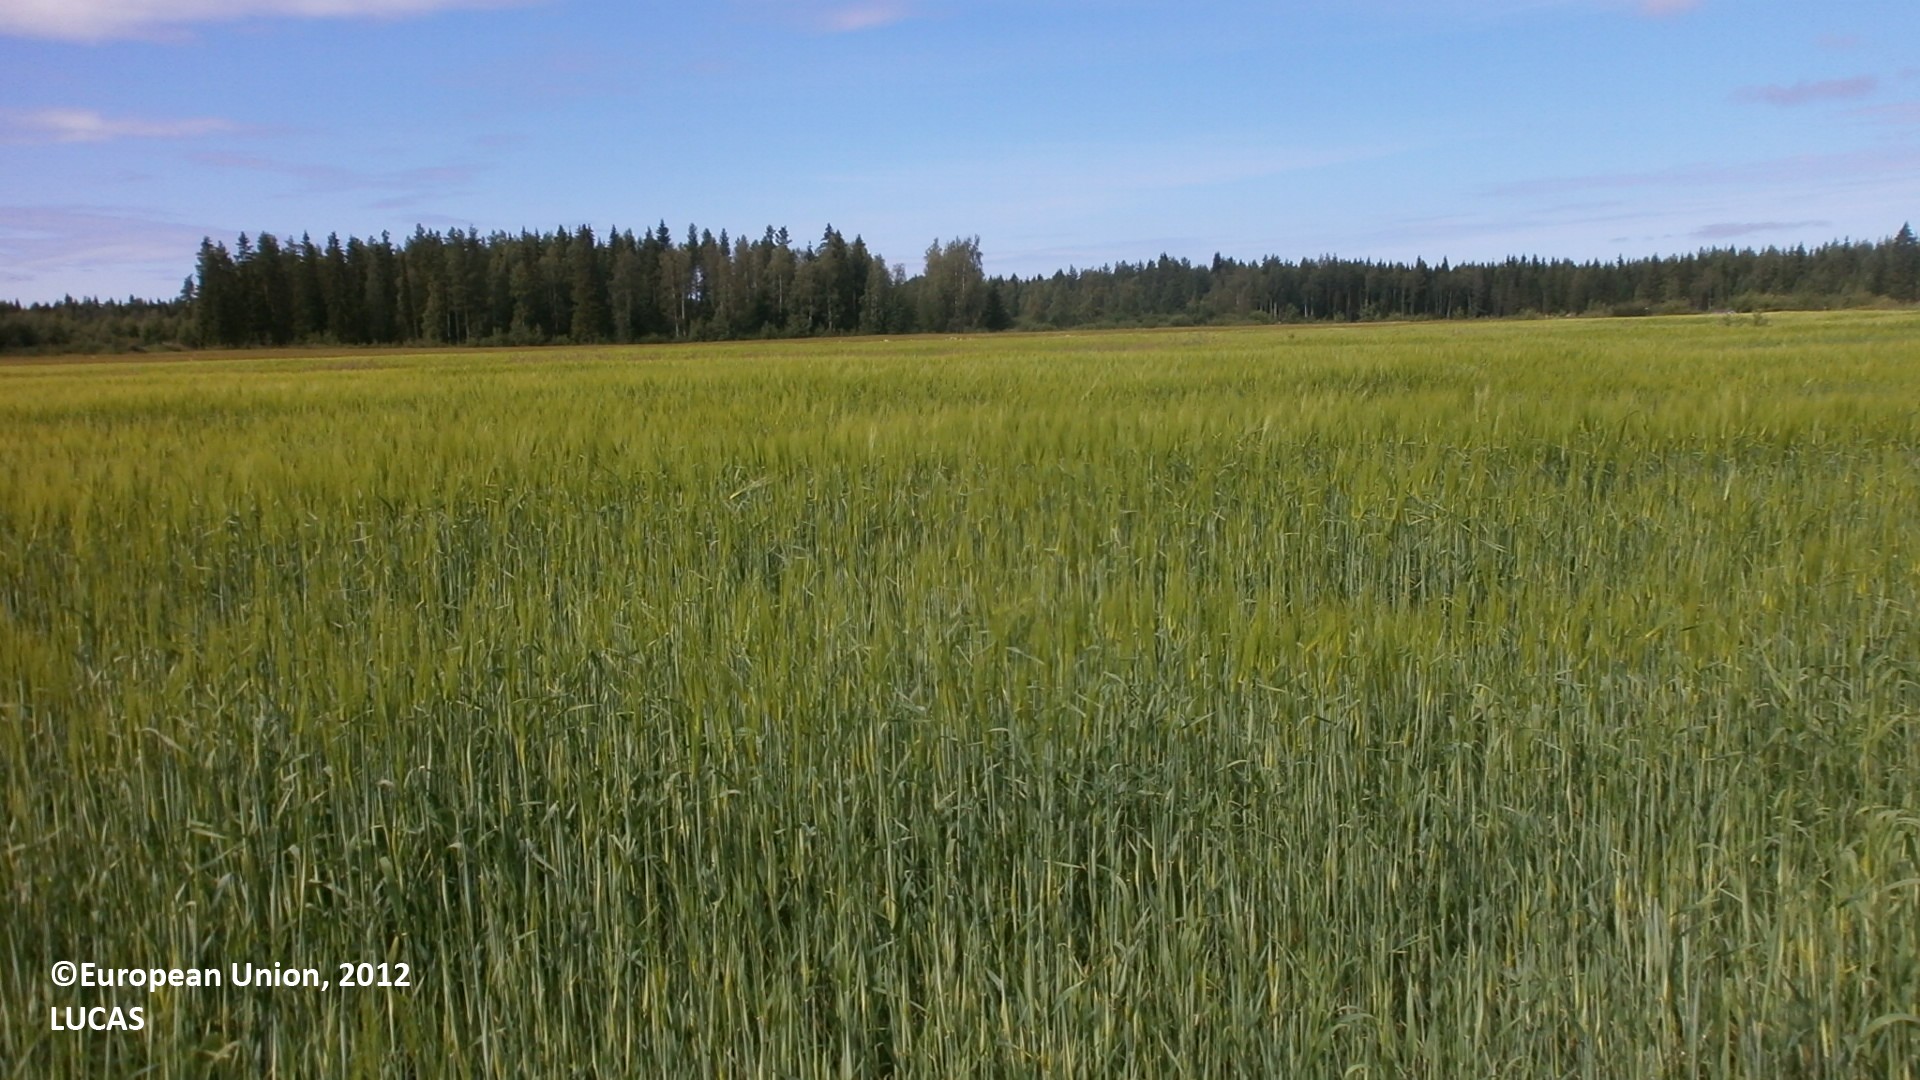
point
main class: Cropland
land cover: Barley
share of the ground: > 75 %
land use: Agriculture (excluding fallow land and kitchen gardens)
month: July
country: FI
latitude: 64.2249
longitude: 23.8915
